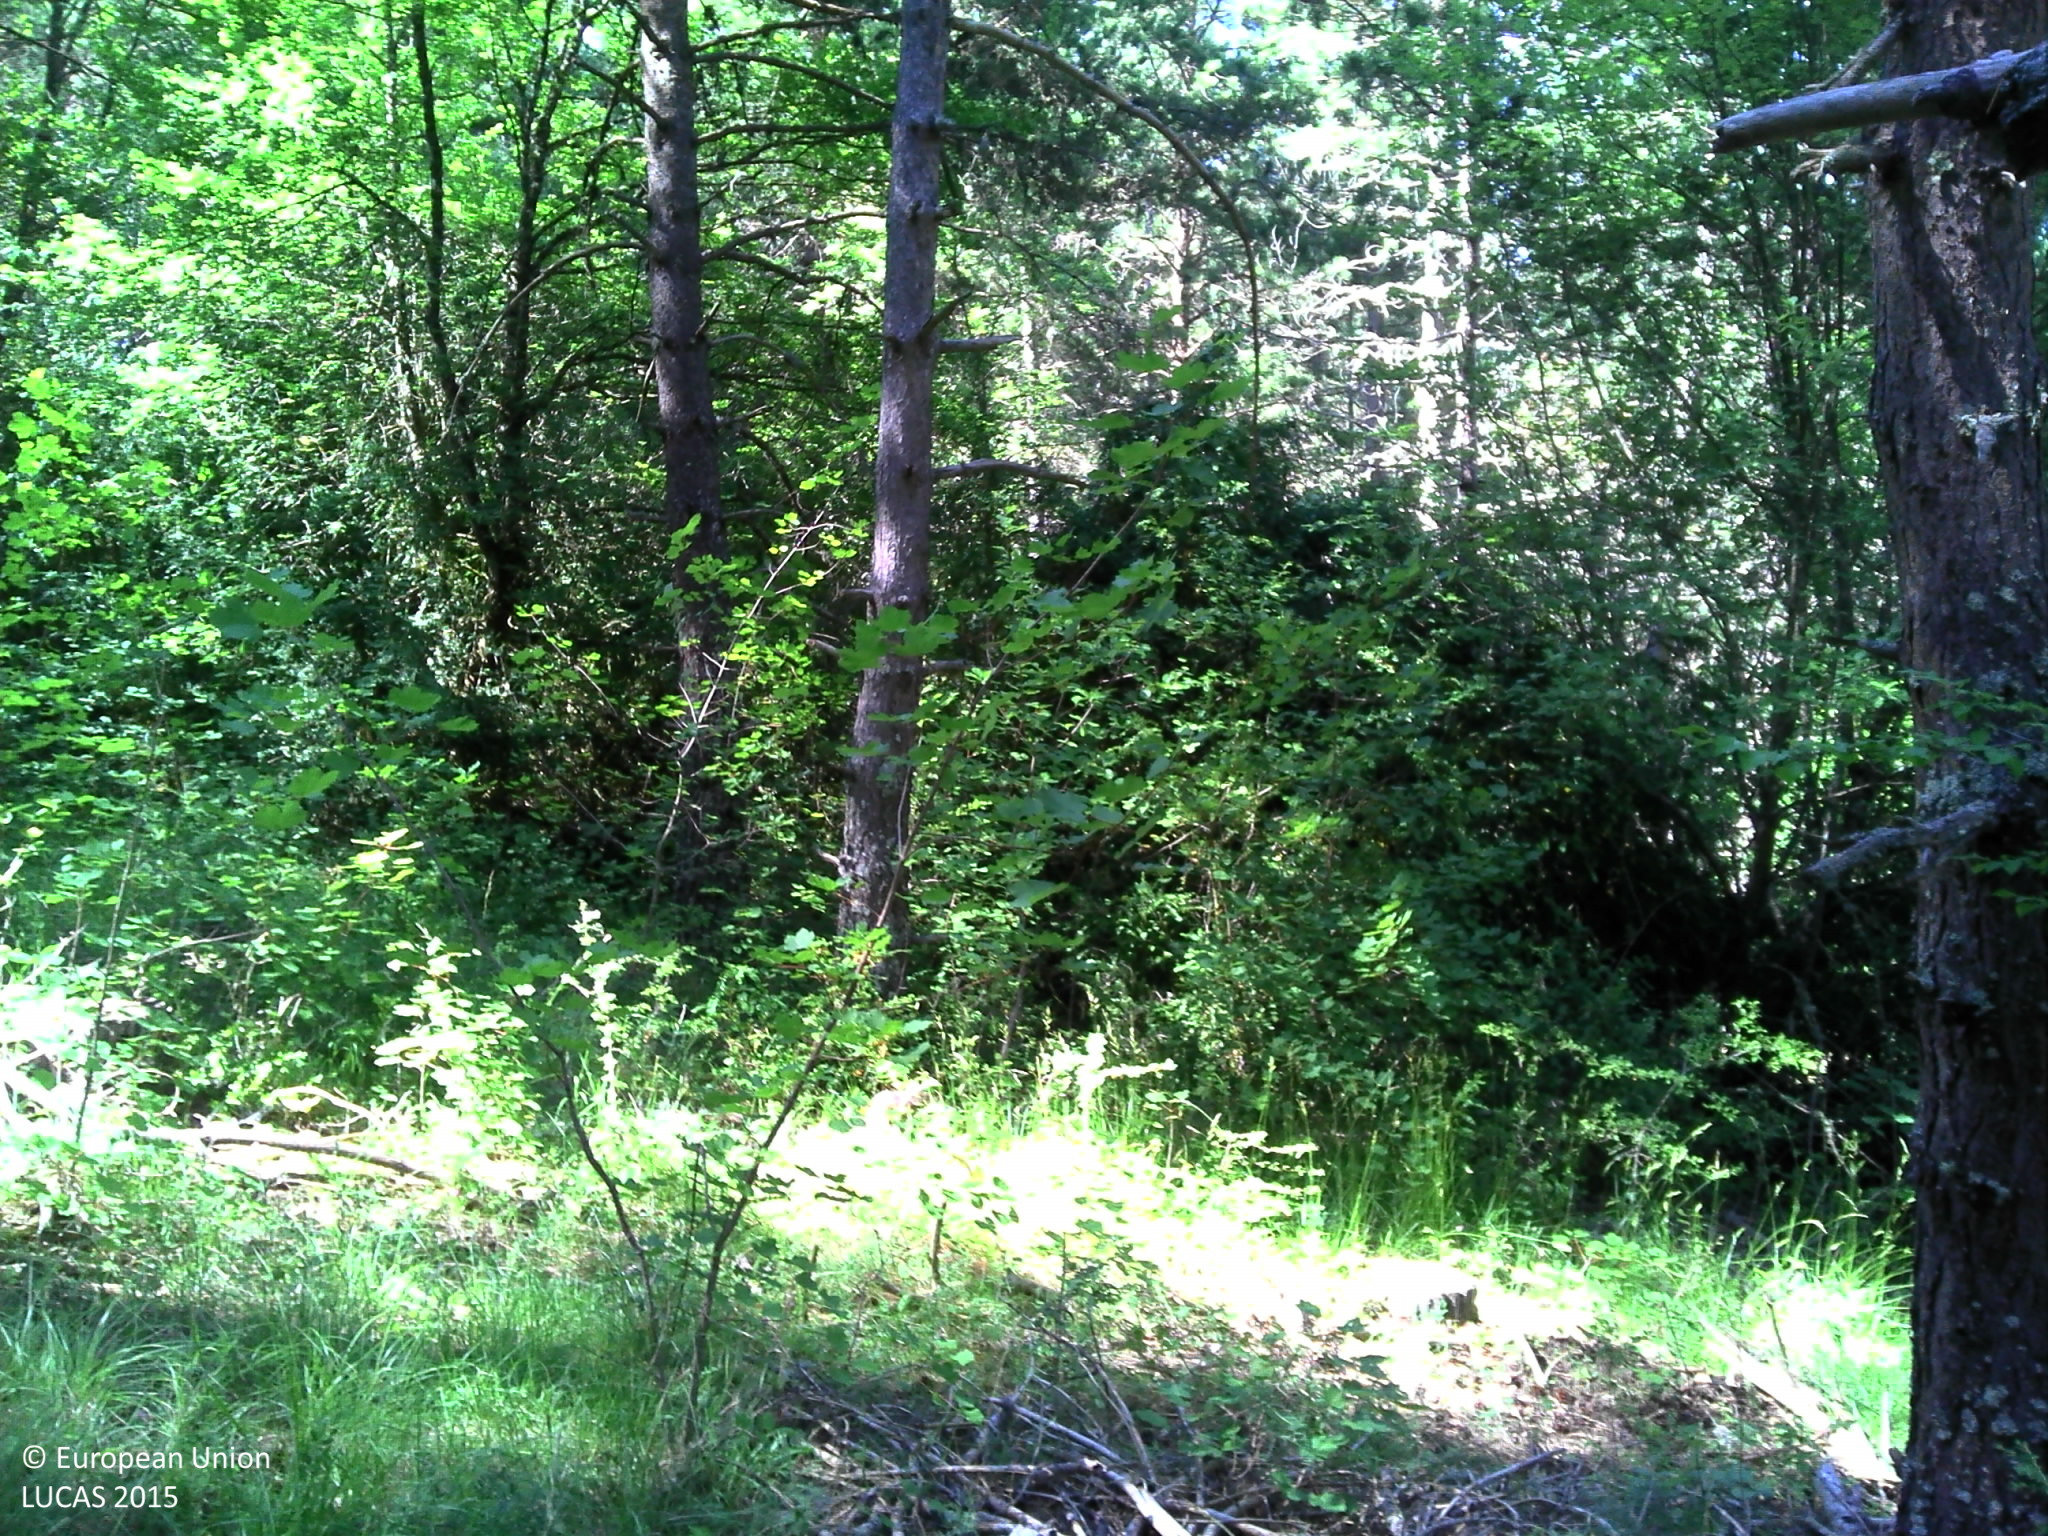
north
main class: Woodland
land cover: Pine dominated coniferous woodland
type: coniferous forest of the mediterranean region
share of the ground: > 75 %
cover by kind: coniferous forest trees 80 %, shrubs 10 %, herbaceous plants 10 %
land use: Forestry
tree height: > 5 m
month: July
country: FR
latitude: 43.8689
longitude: 6.2874
